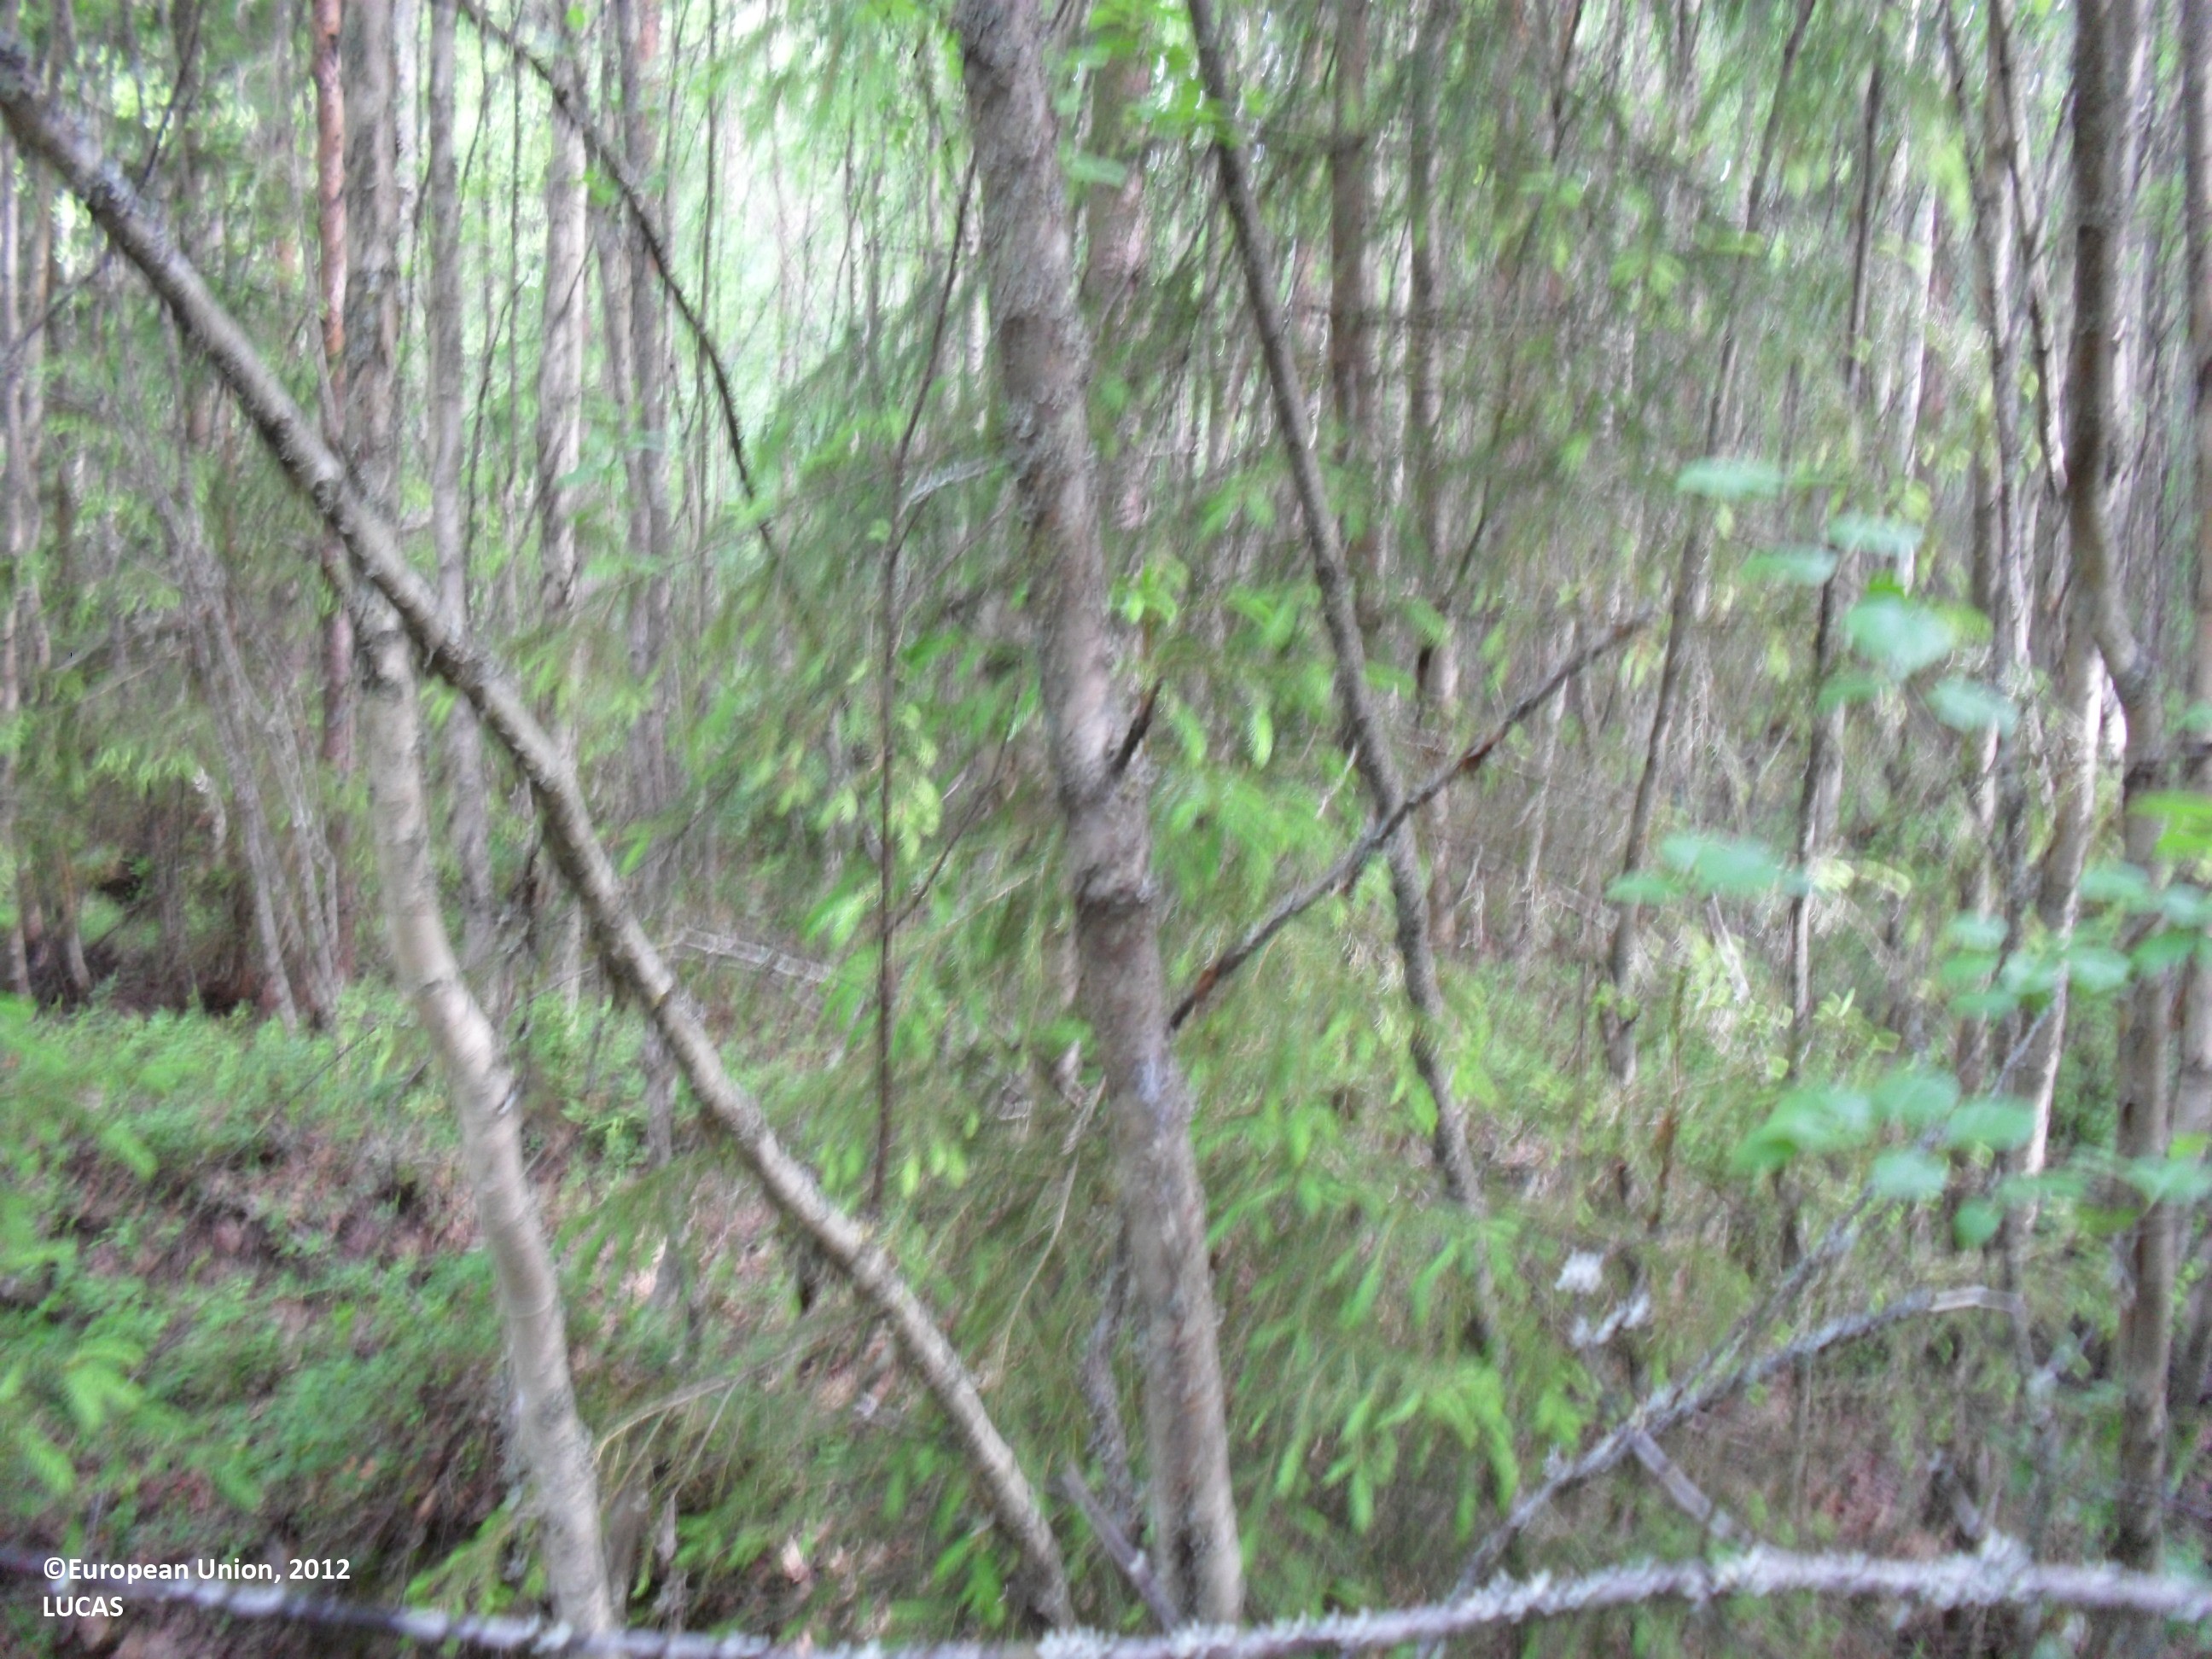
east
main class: Woodland
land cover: Other mixed woodland
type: boreal forest
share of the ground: > 75 %
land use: Forestry
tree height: > 5 m
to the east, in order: Other mixed woodland; Grass margins; Ditches and canals; Other mixed woodland; Pine dominated mixed woodland; Ditches and canals; Pine dominated mixed woodland; Other mixed woodland; Ditches and canals; Other mixed woodland; Ditches and canals; Grass margins; Tracks; Grass margins; Ditches and canals; Spruce dominated coniferous woodland; Ditches and canals; Spruce dominated coniferous woodland; Ditches and canals; Spruce dominated coniferous woodland
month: June
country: FI
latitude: 62.7263
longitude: 23.3882
